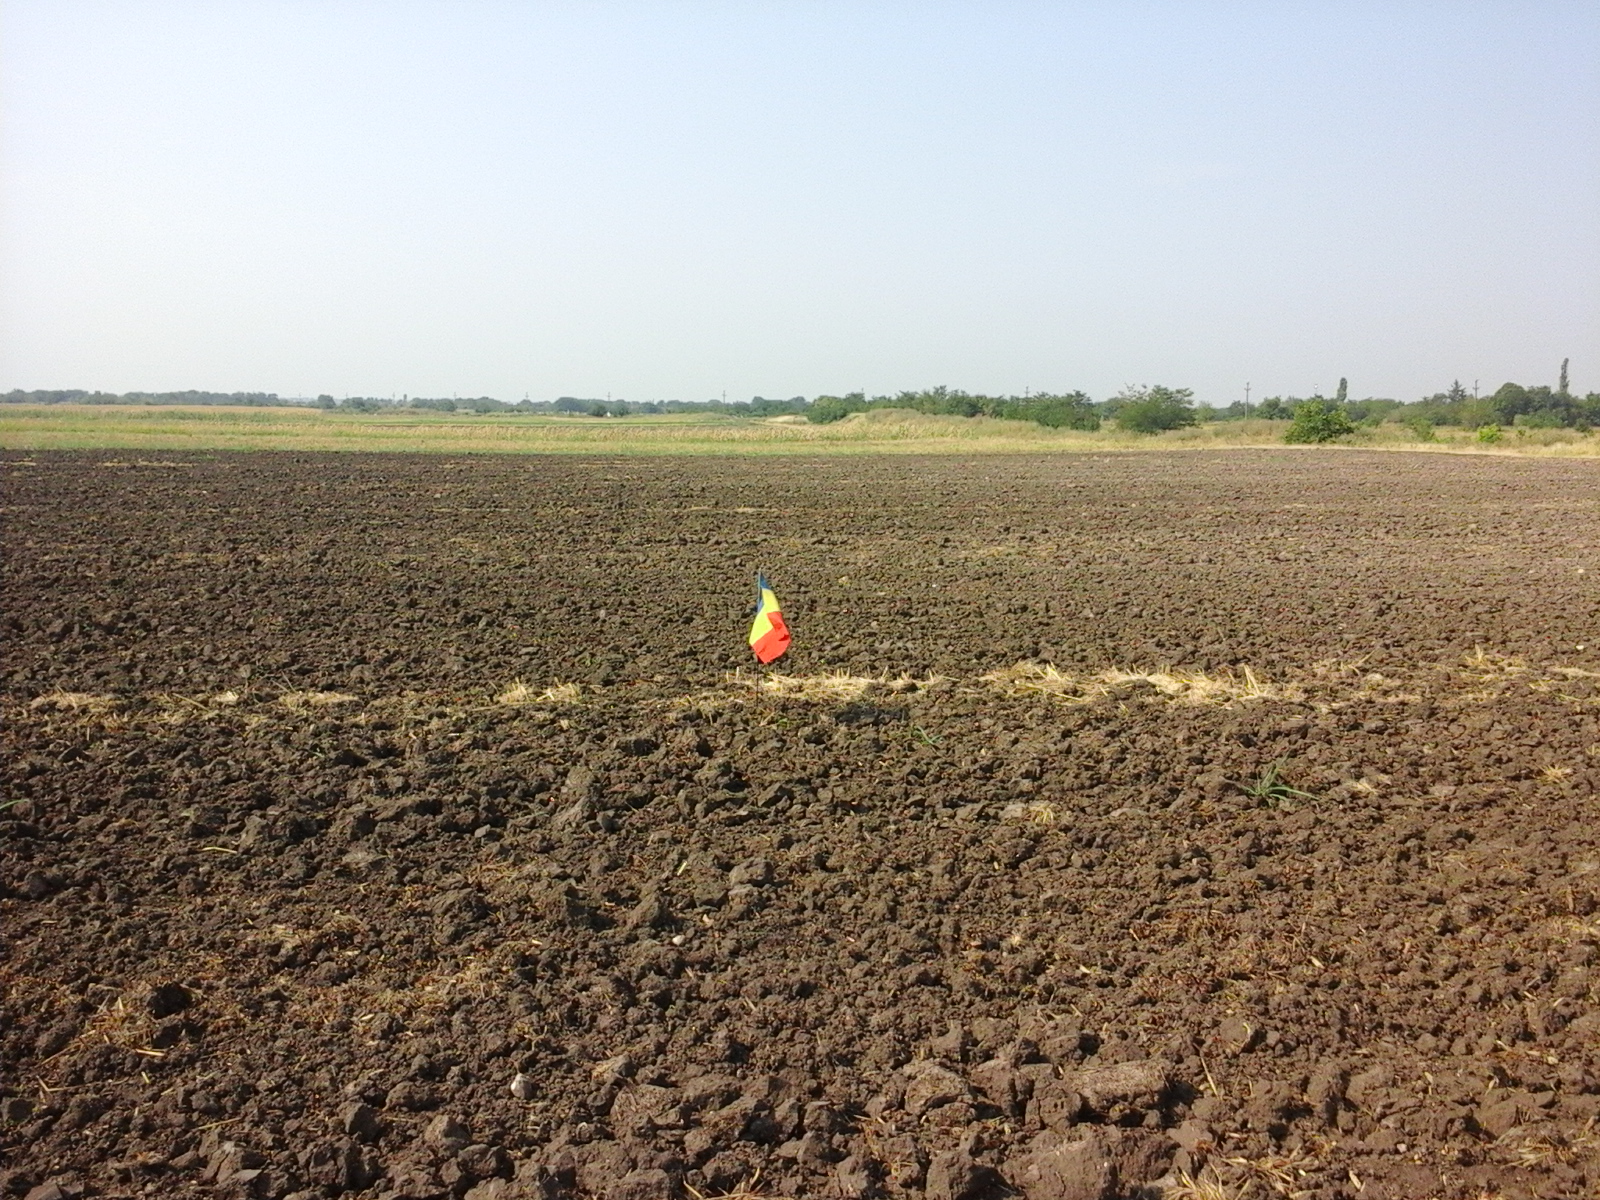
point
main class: Cropland
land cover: Common wheat
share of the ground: < 10 %
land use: Agriculture (excluding fallow land and kitchen gardens)
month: August
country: RO
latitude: 44.0494
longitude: 23.4917
